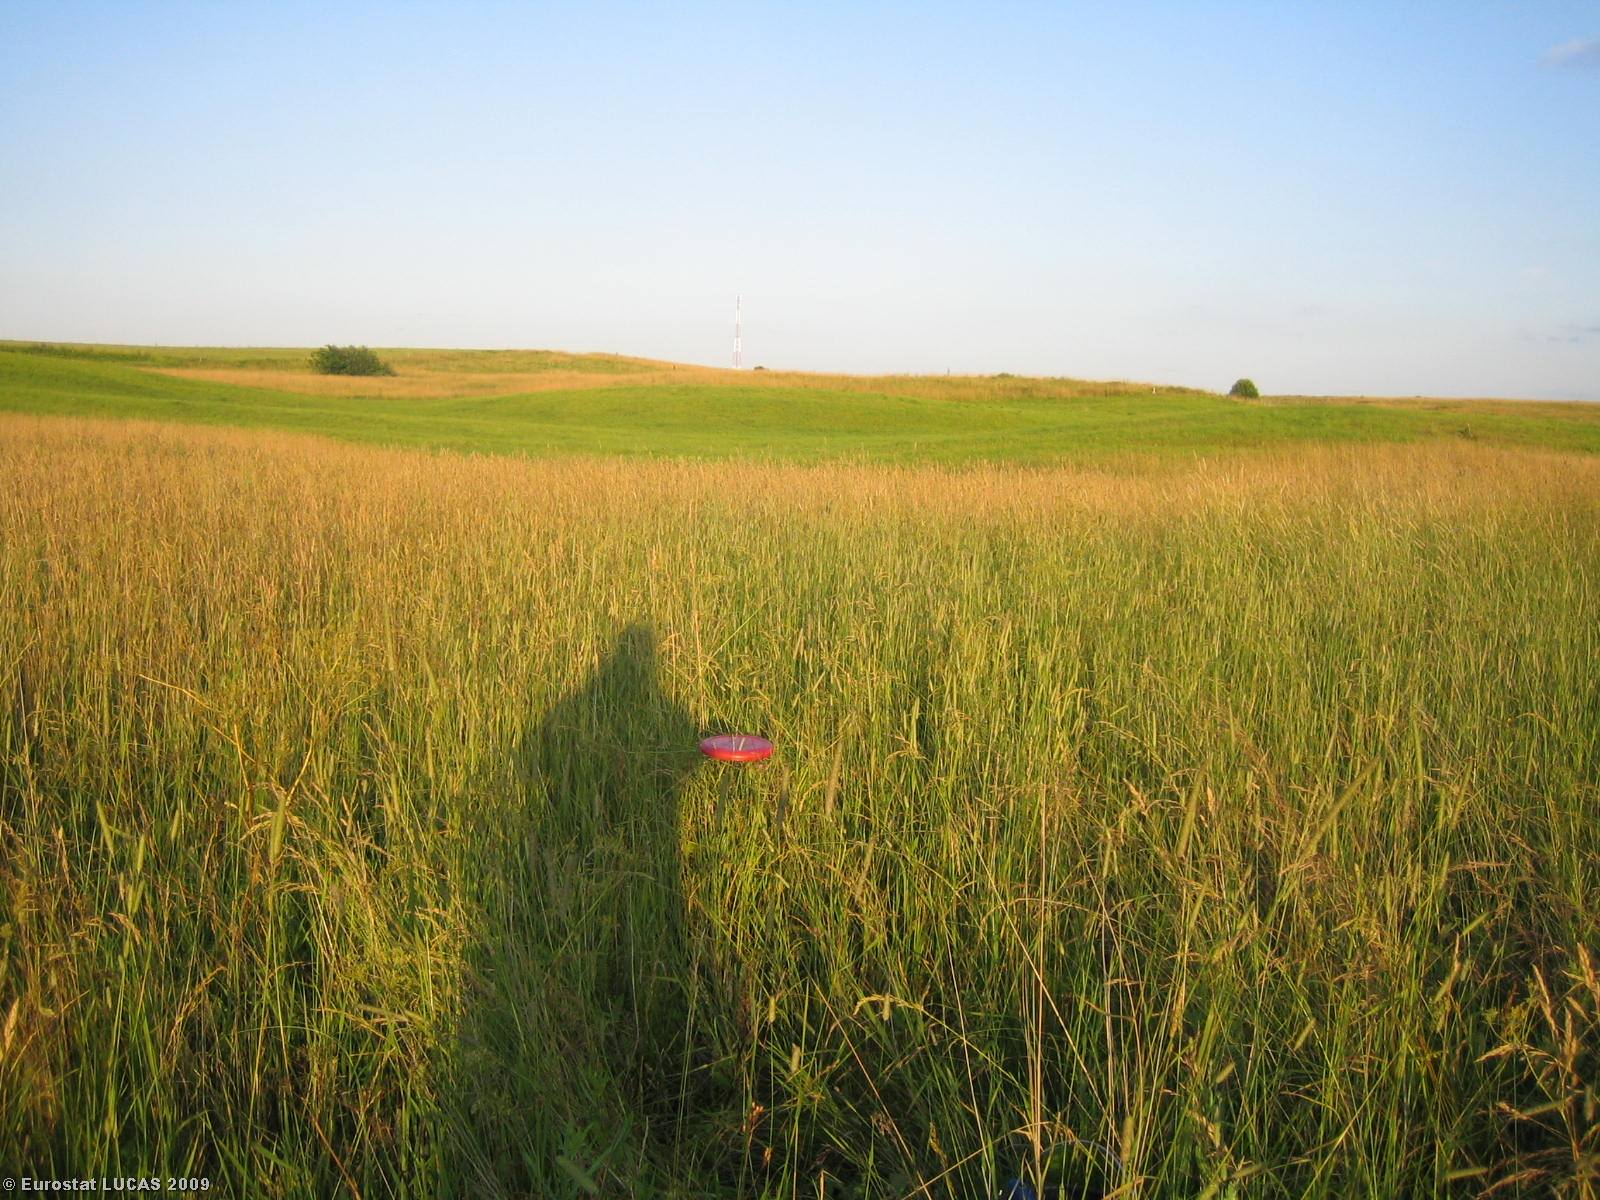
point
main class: Grassland
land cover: Grassland without tree/shrub cover
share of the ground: > 75 %
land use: Agriculture (excluding fallow land and kitchen gardens)
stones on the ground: < 10 %
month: July
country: LT
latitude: 55.8460
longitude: 26.0615
